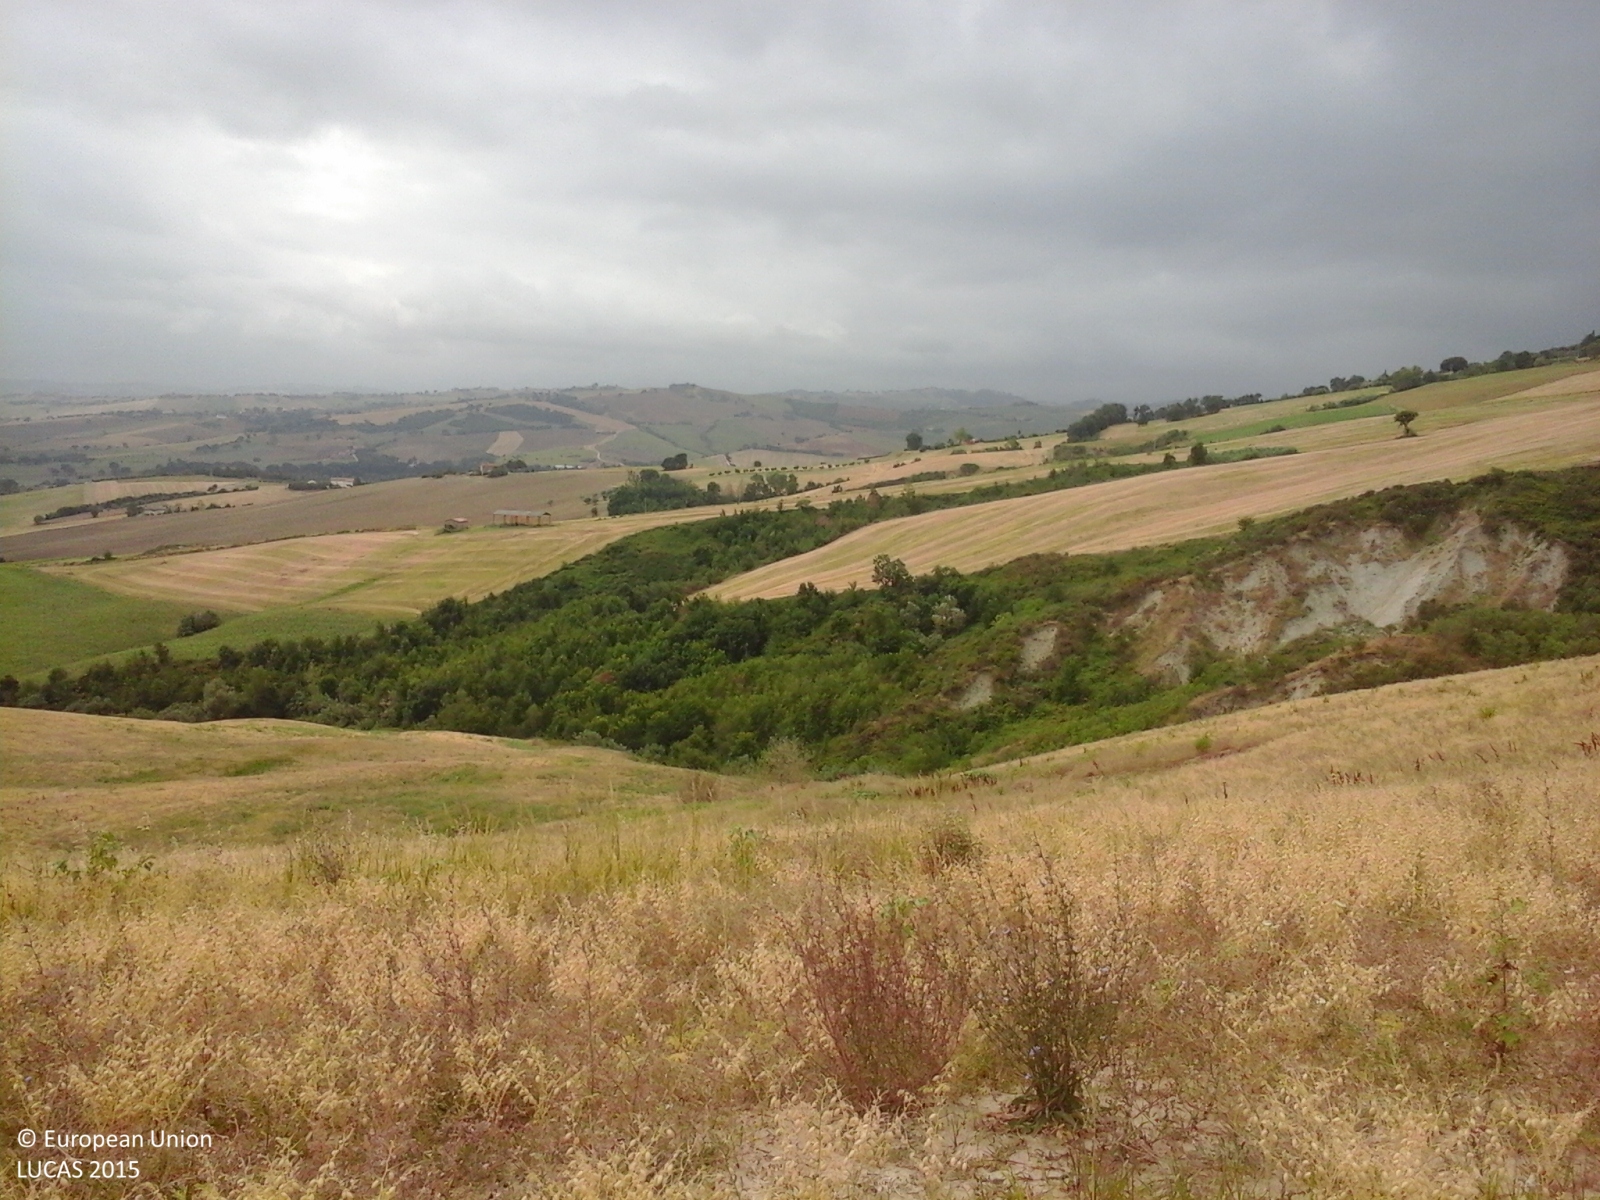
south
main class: Cropland
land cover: Dry pulses
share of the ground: > 75 %
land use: Agriculture (excluding fallow land and kitchen gardens)
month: July
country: IT
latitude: 43.2883
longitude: 13.2575
